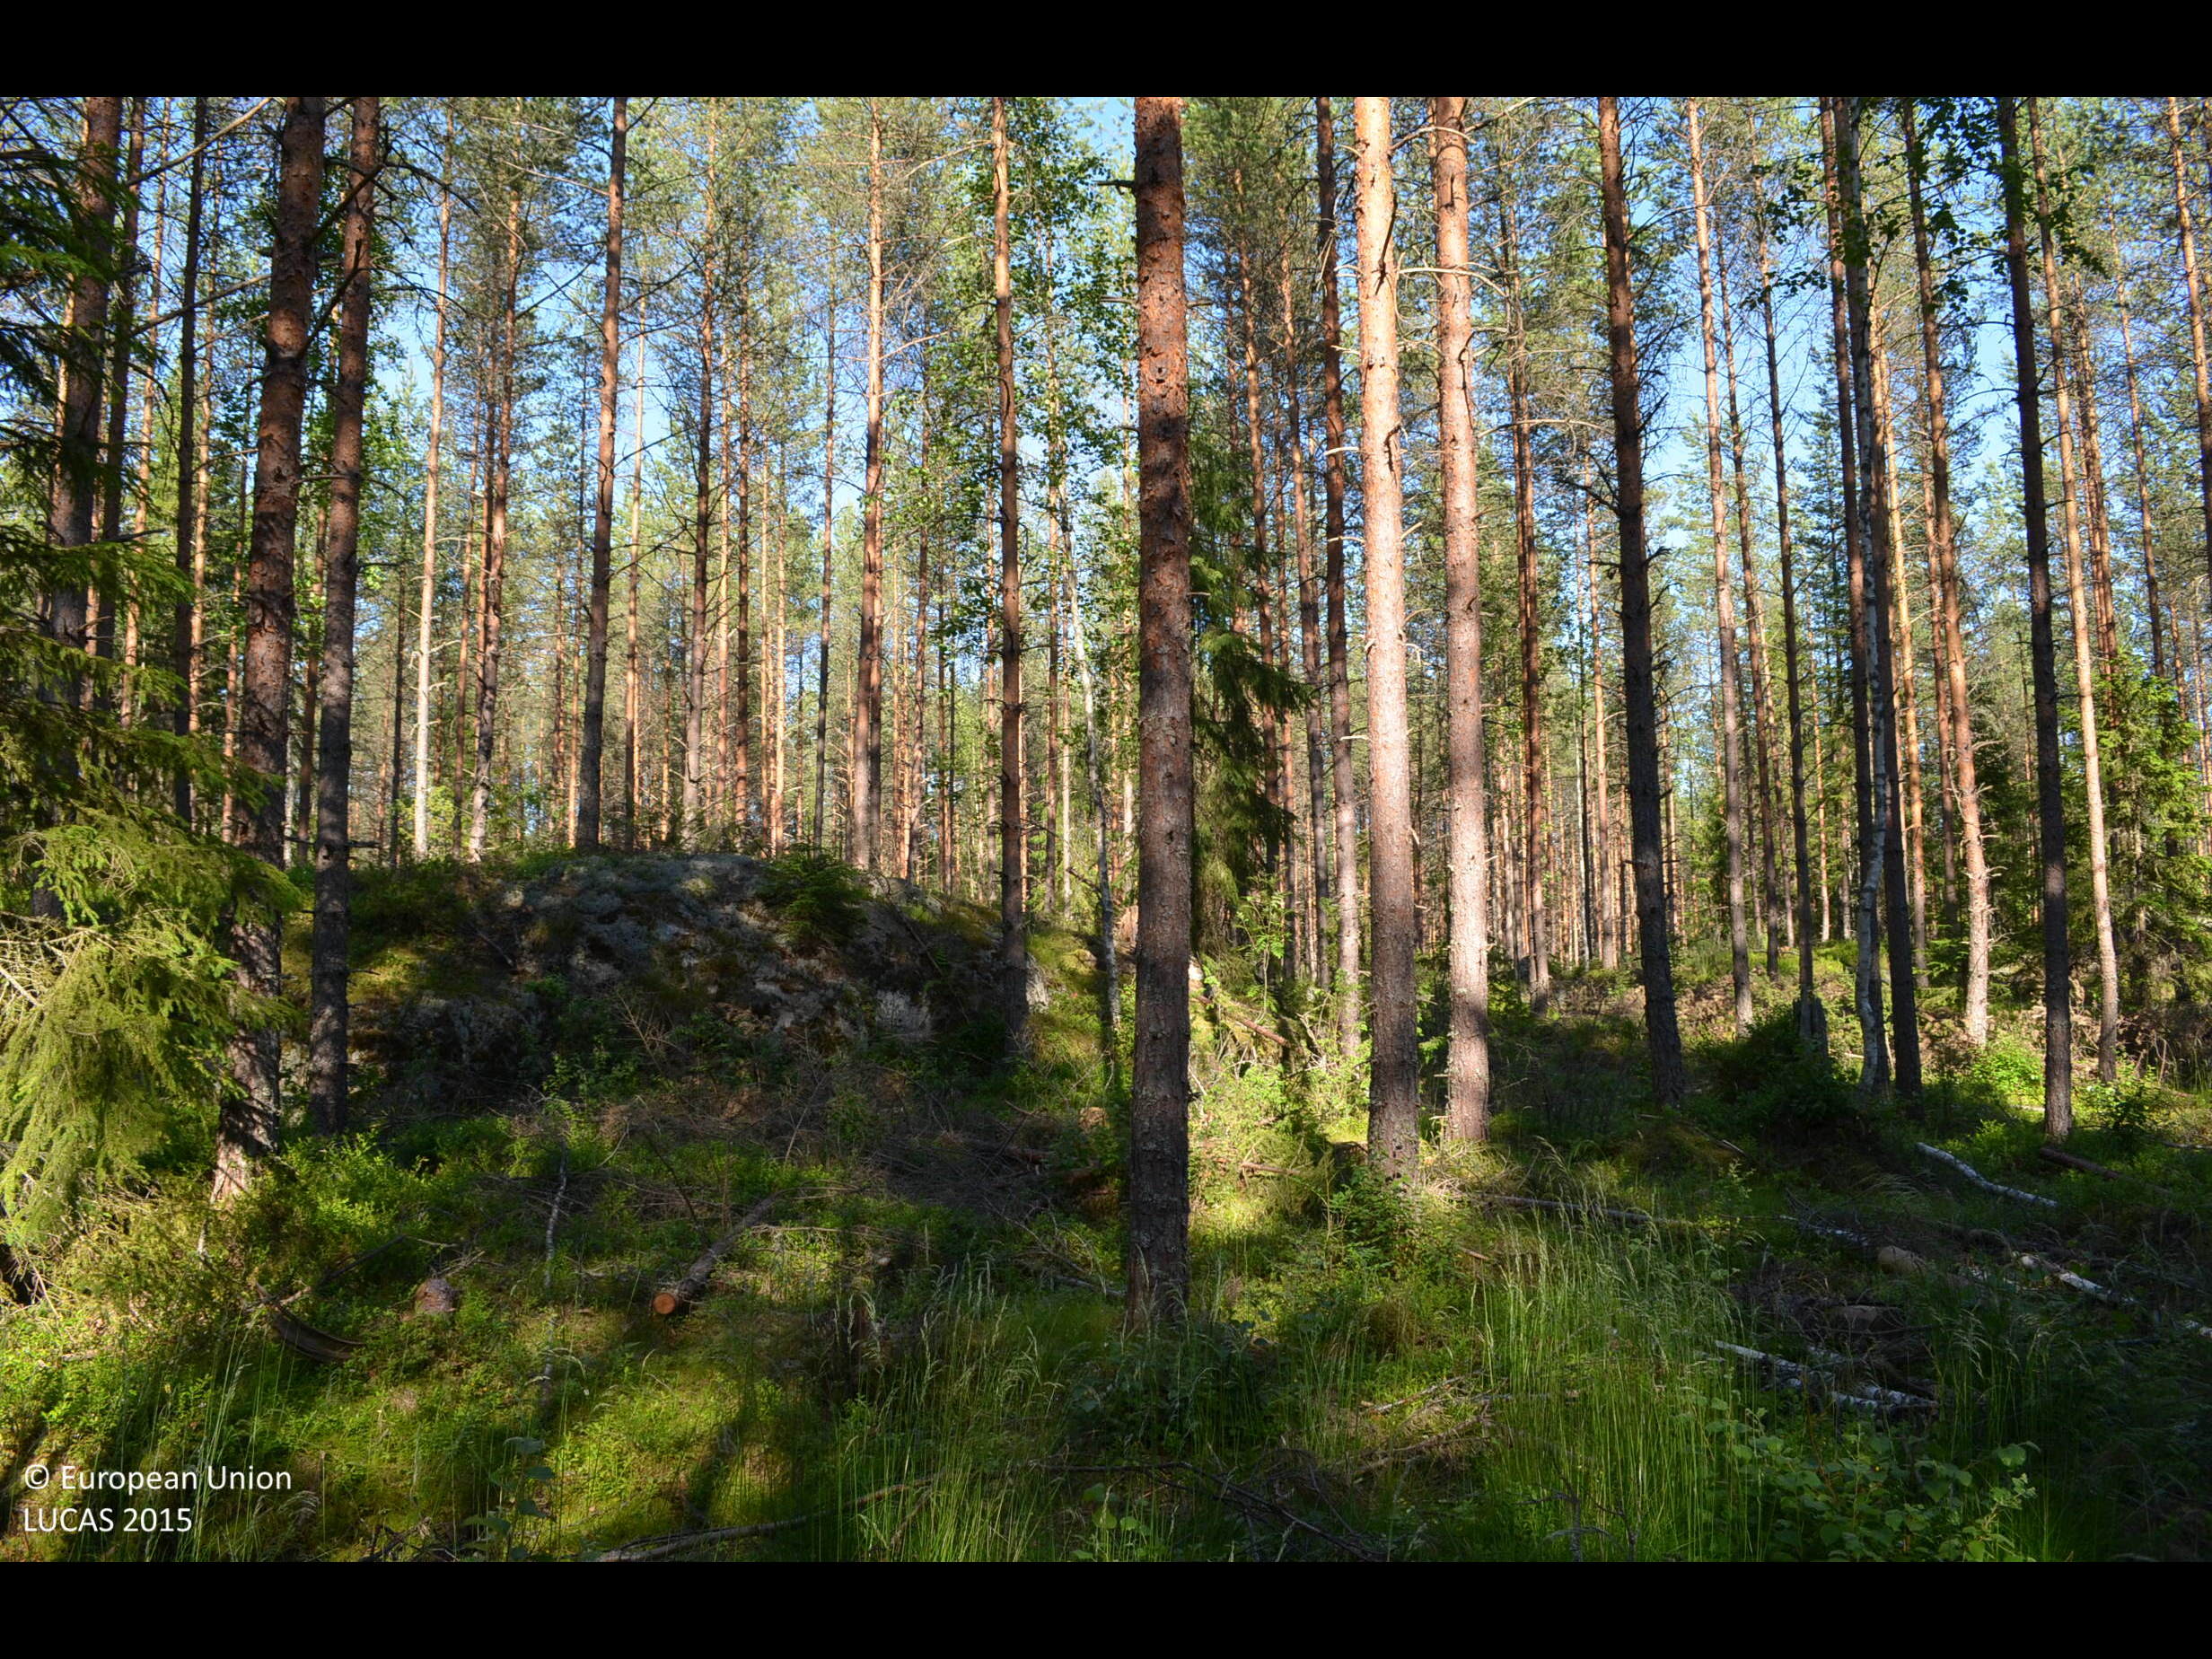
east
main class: Woodland
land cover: Pine dominated coniferous woodland
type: boreal forest
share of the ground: > 75 %
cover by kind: coniferous forest trees 70 %, shrubs 15 %, broadleaved forest trees 10 %, herbaceous plants 5 %
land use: Forestry
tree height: > 5 m
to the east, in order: Pine dominated coniferous woodland; Pine dominated mixed woodland; Ditches and canals; Grass margins; Paved roads, cycling and walking lanes; Grass margins; Ditches and canals; Ponds and wetlands; Other mixed woodland; Rivers and streams; Other mixed woodland; Other coniferous woodland; Pine dominated mixed woodland
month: July
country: FI
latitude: 61.7683
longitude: 23.4359
